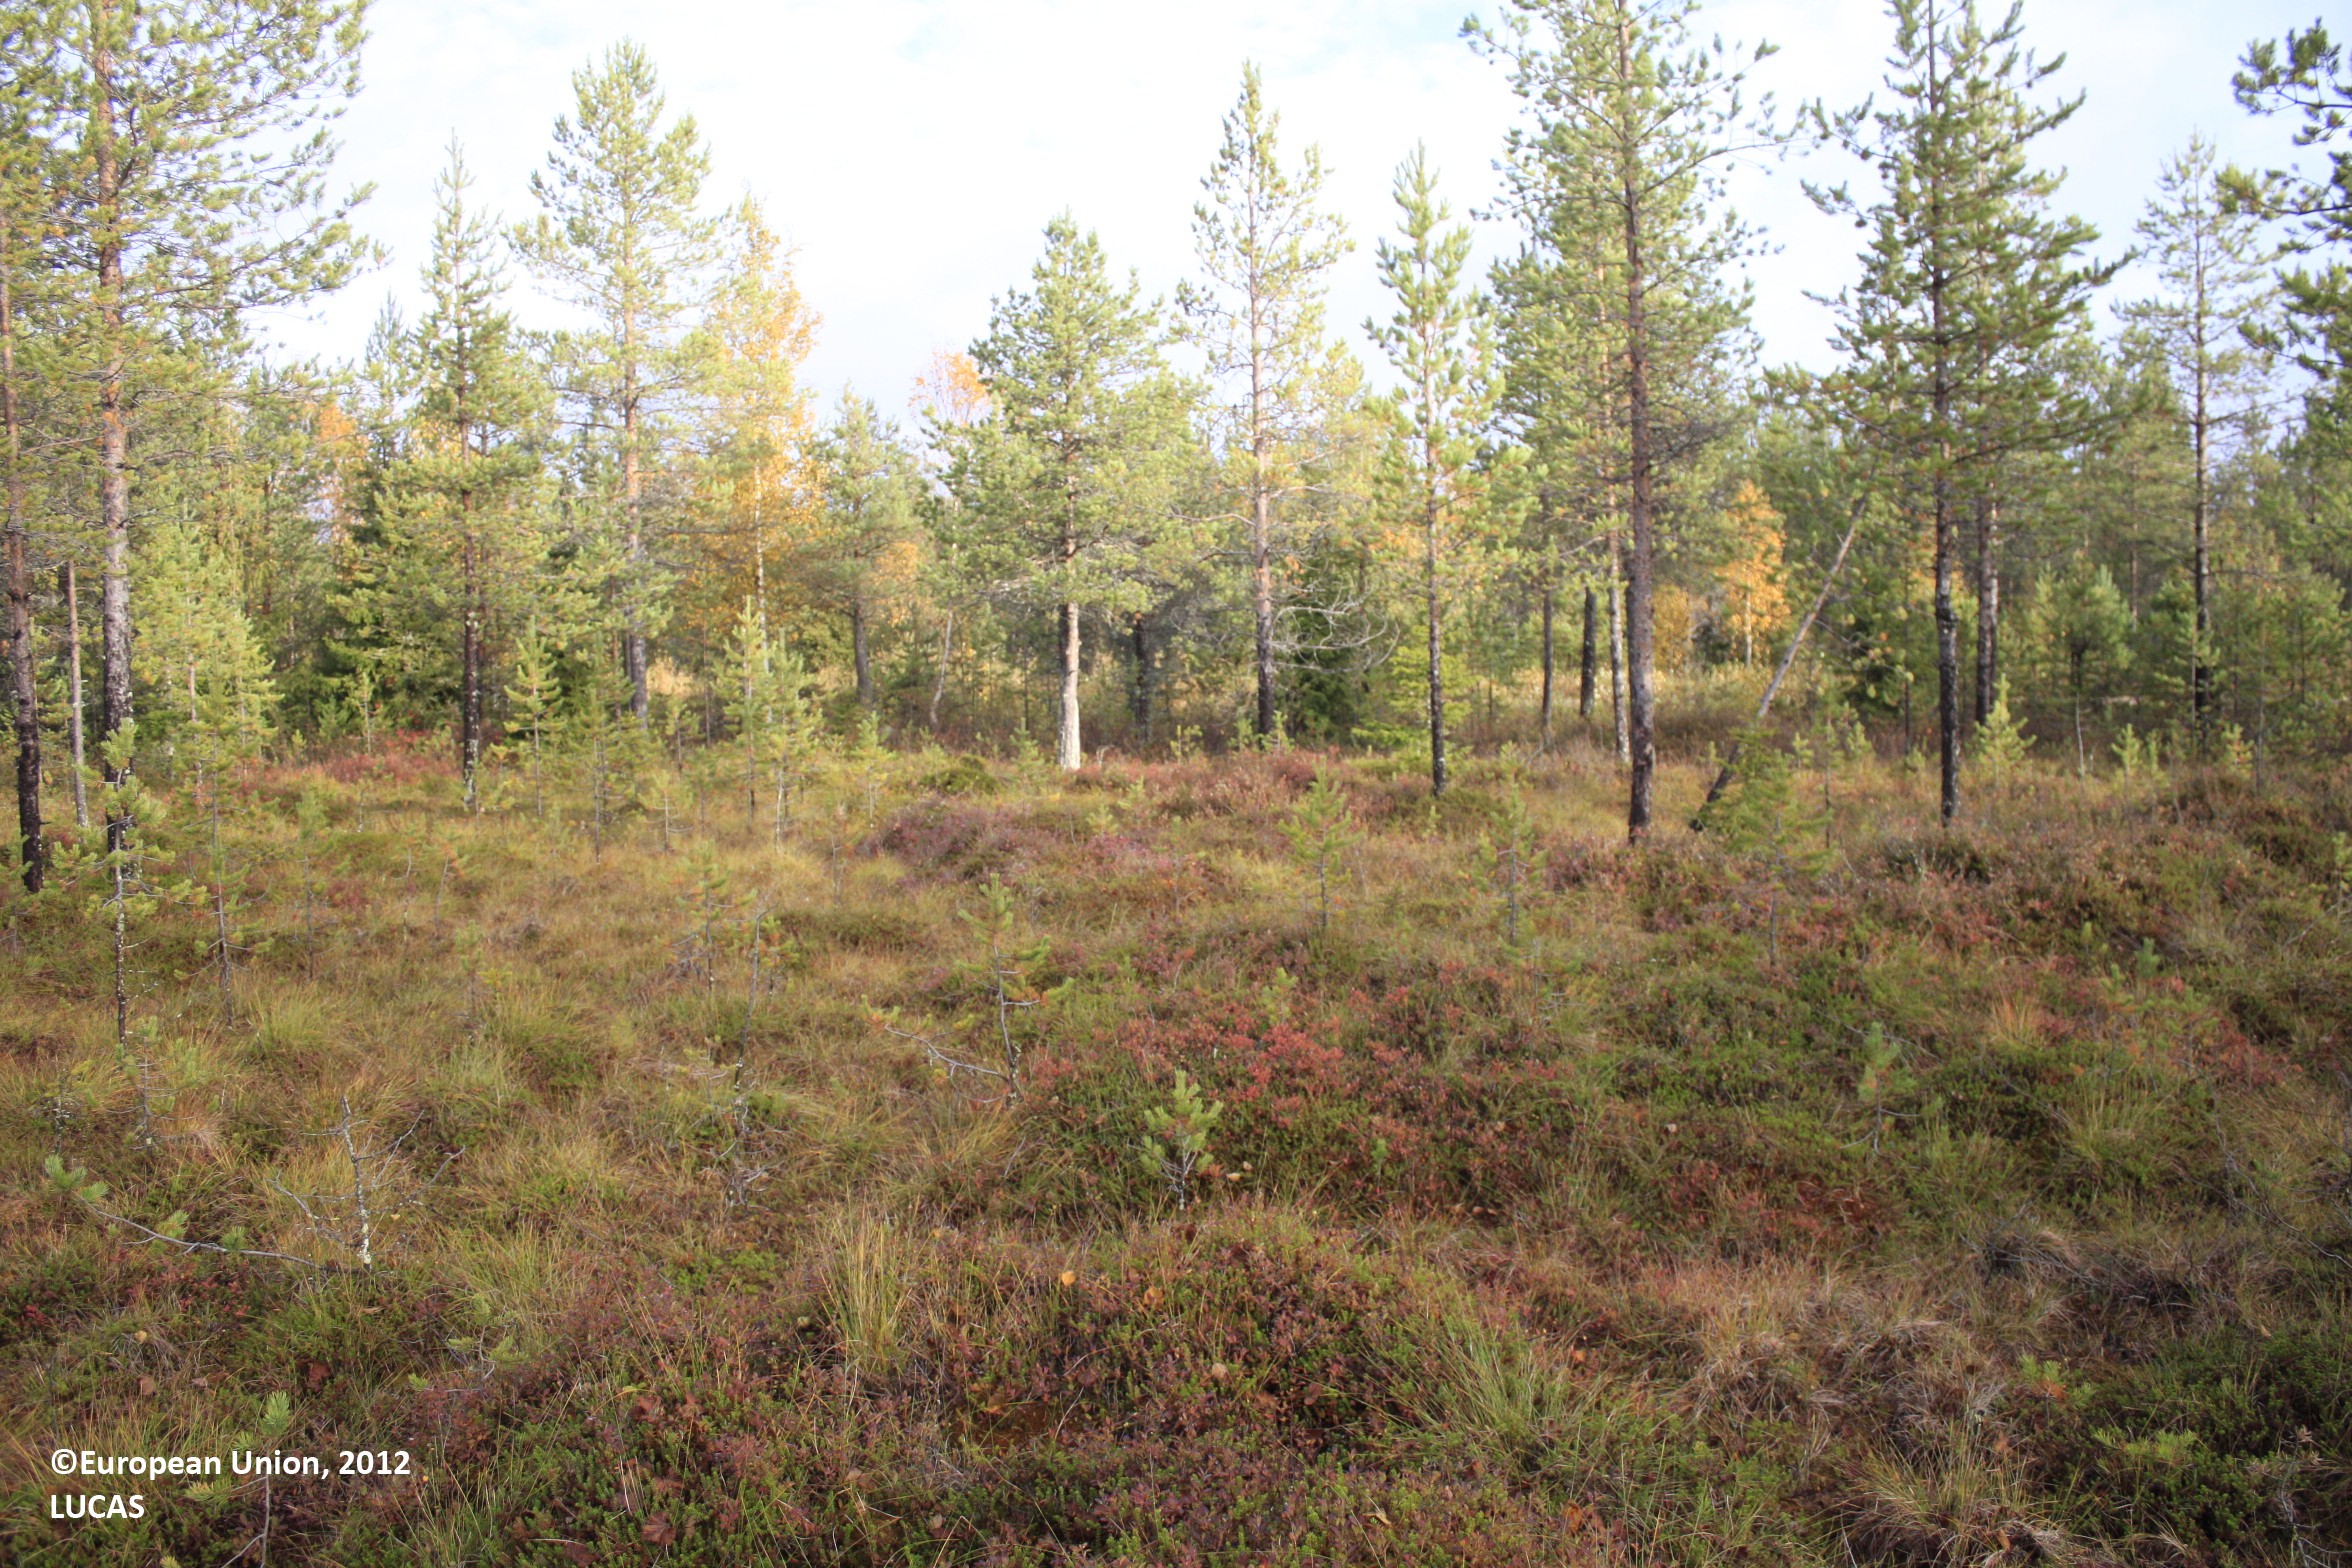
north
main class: Grassland
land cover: Grassland without tree/shrub cover
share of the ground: 25 - 50 %
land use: Agriculture (excluding fallow land and kitchen gardens)
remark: Tilled/Sowed
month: September
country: FI
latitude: 66.0336
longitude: 26.8483
